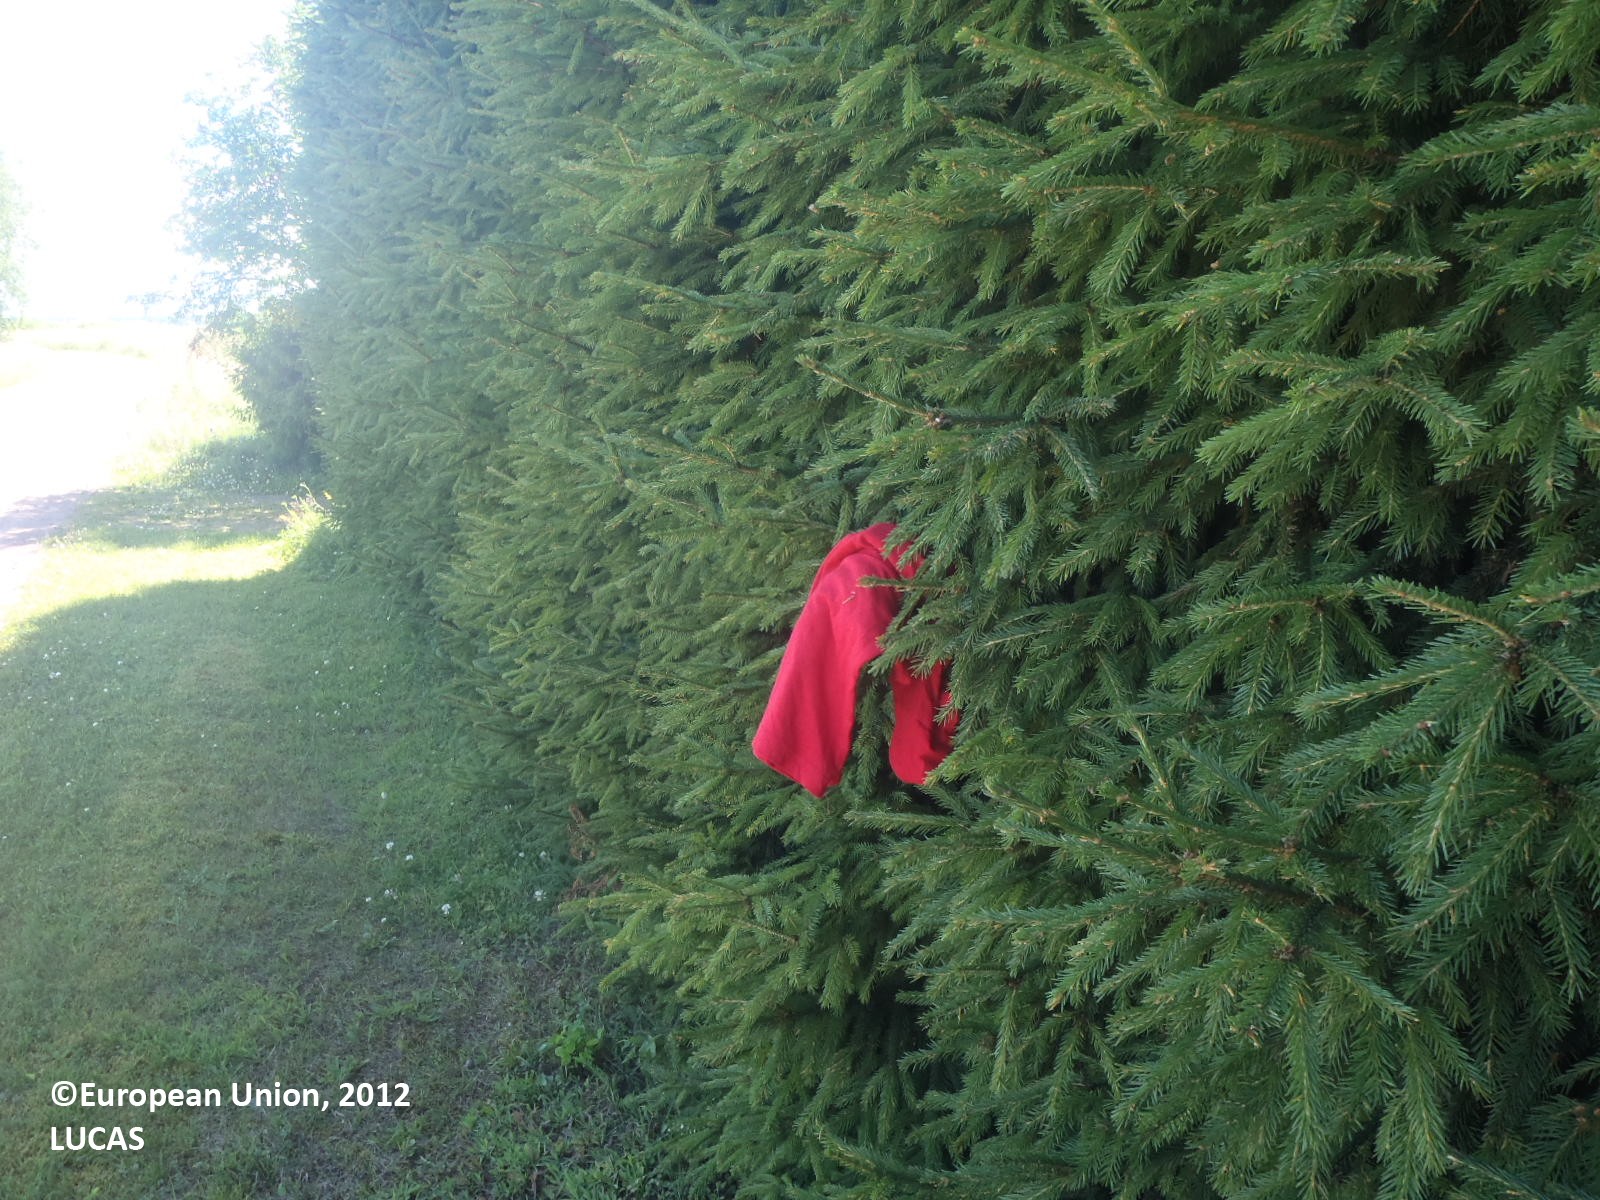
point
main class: Woodland
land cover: Spruce dominated coniferous woodland
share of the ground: > 75 %
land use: Residential
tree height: < 5 m
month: July
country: FI
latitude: 61.1940
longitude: 22.0593
